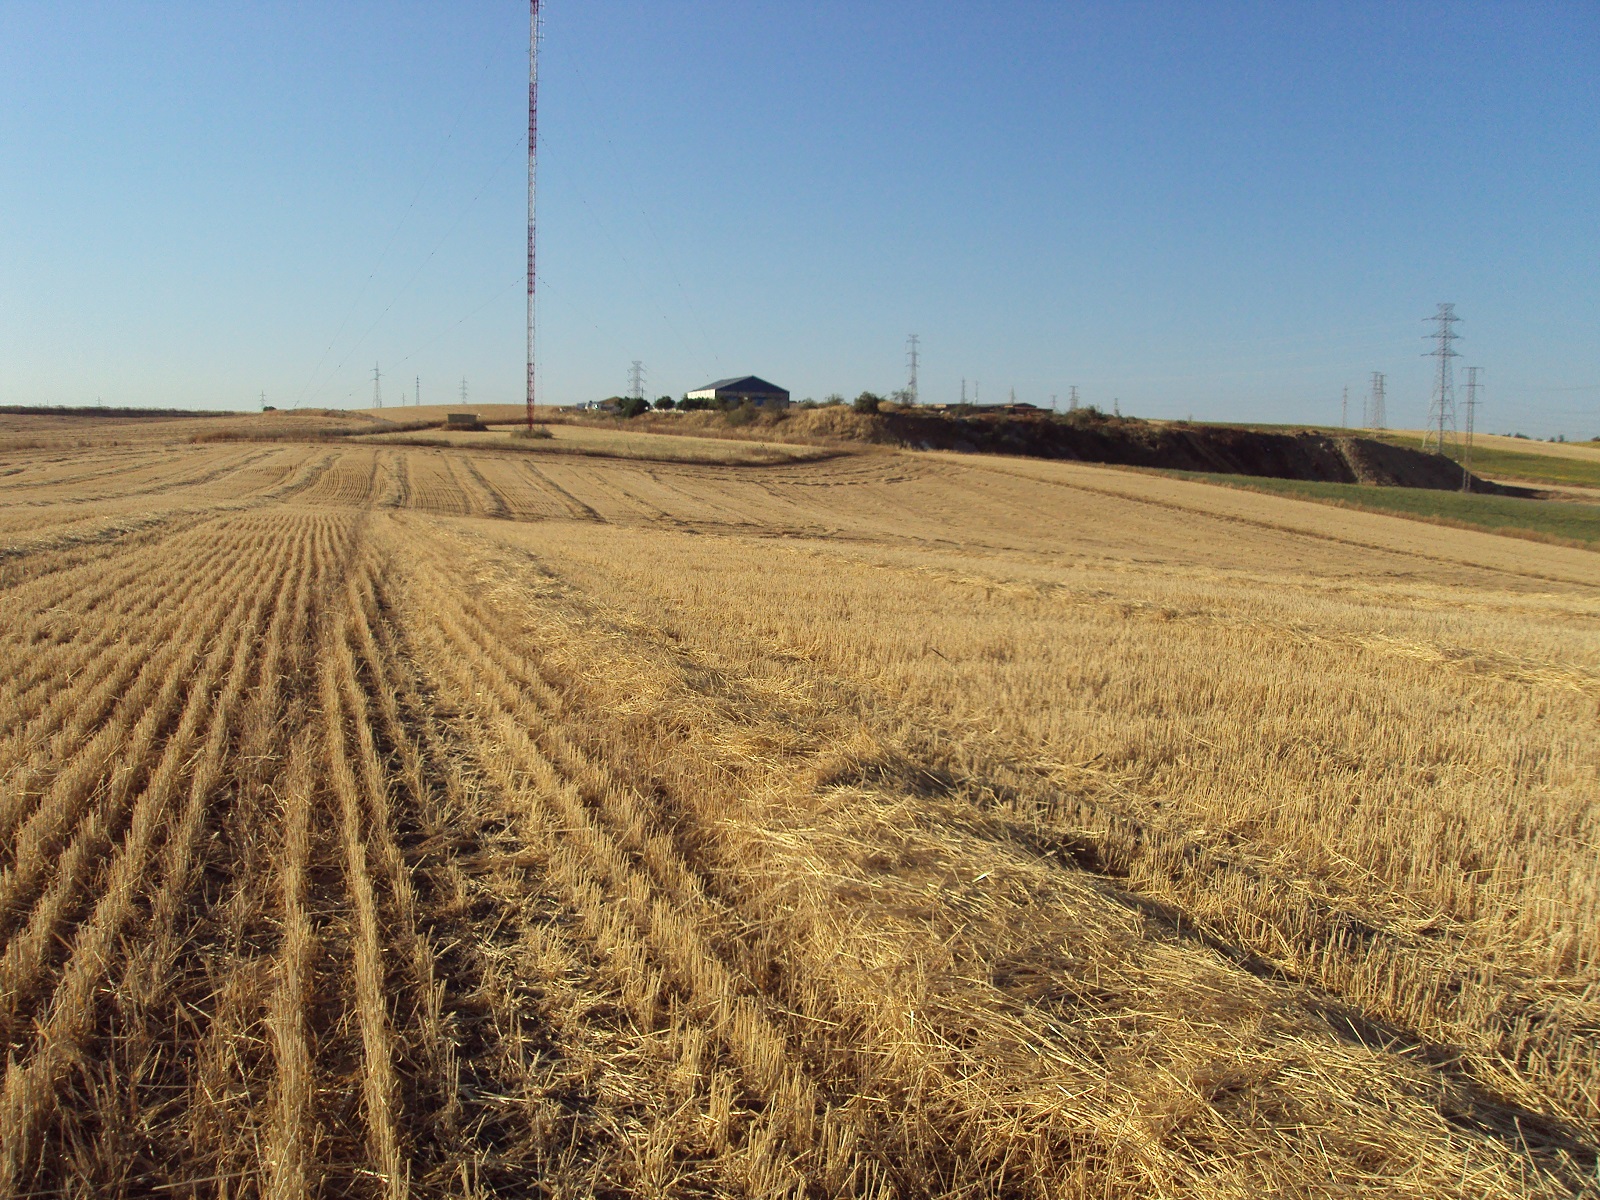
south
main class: Cropland
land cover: Durum wheat
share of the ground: > 75 %
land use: Agriculture (excluding fallow land and kitchen gardens)
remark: Harvested field
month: June
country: ES
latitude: 37.3077
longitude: -6.9290
